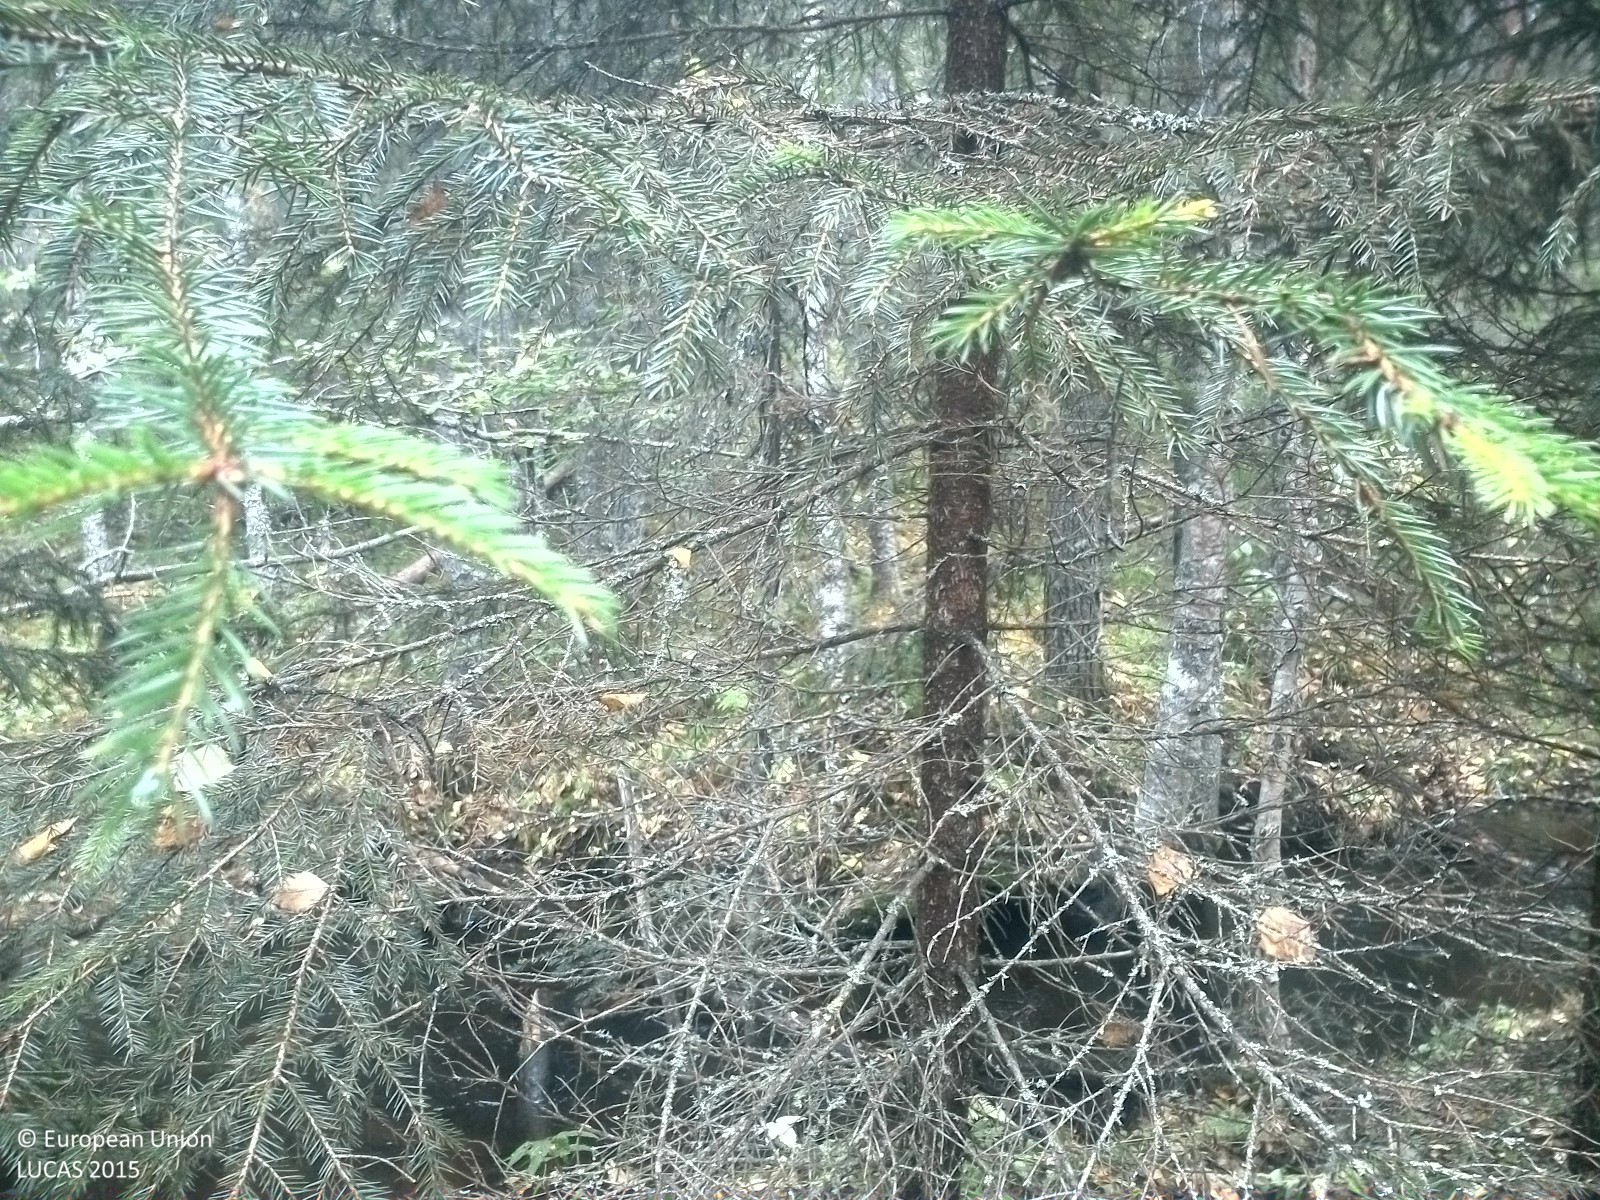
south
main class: Woodland
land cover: Spruce dominated mixed woodland
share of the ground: 50 - 75 %
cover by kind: coniferous forest trees 45 %, broadleaved forest trees 25 %, herbaceous plants 15 %, lichens and mosses 15 %
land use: Forestry
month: September
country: SE
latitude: 62.1825
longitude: 15.6092
